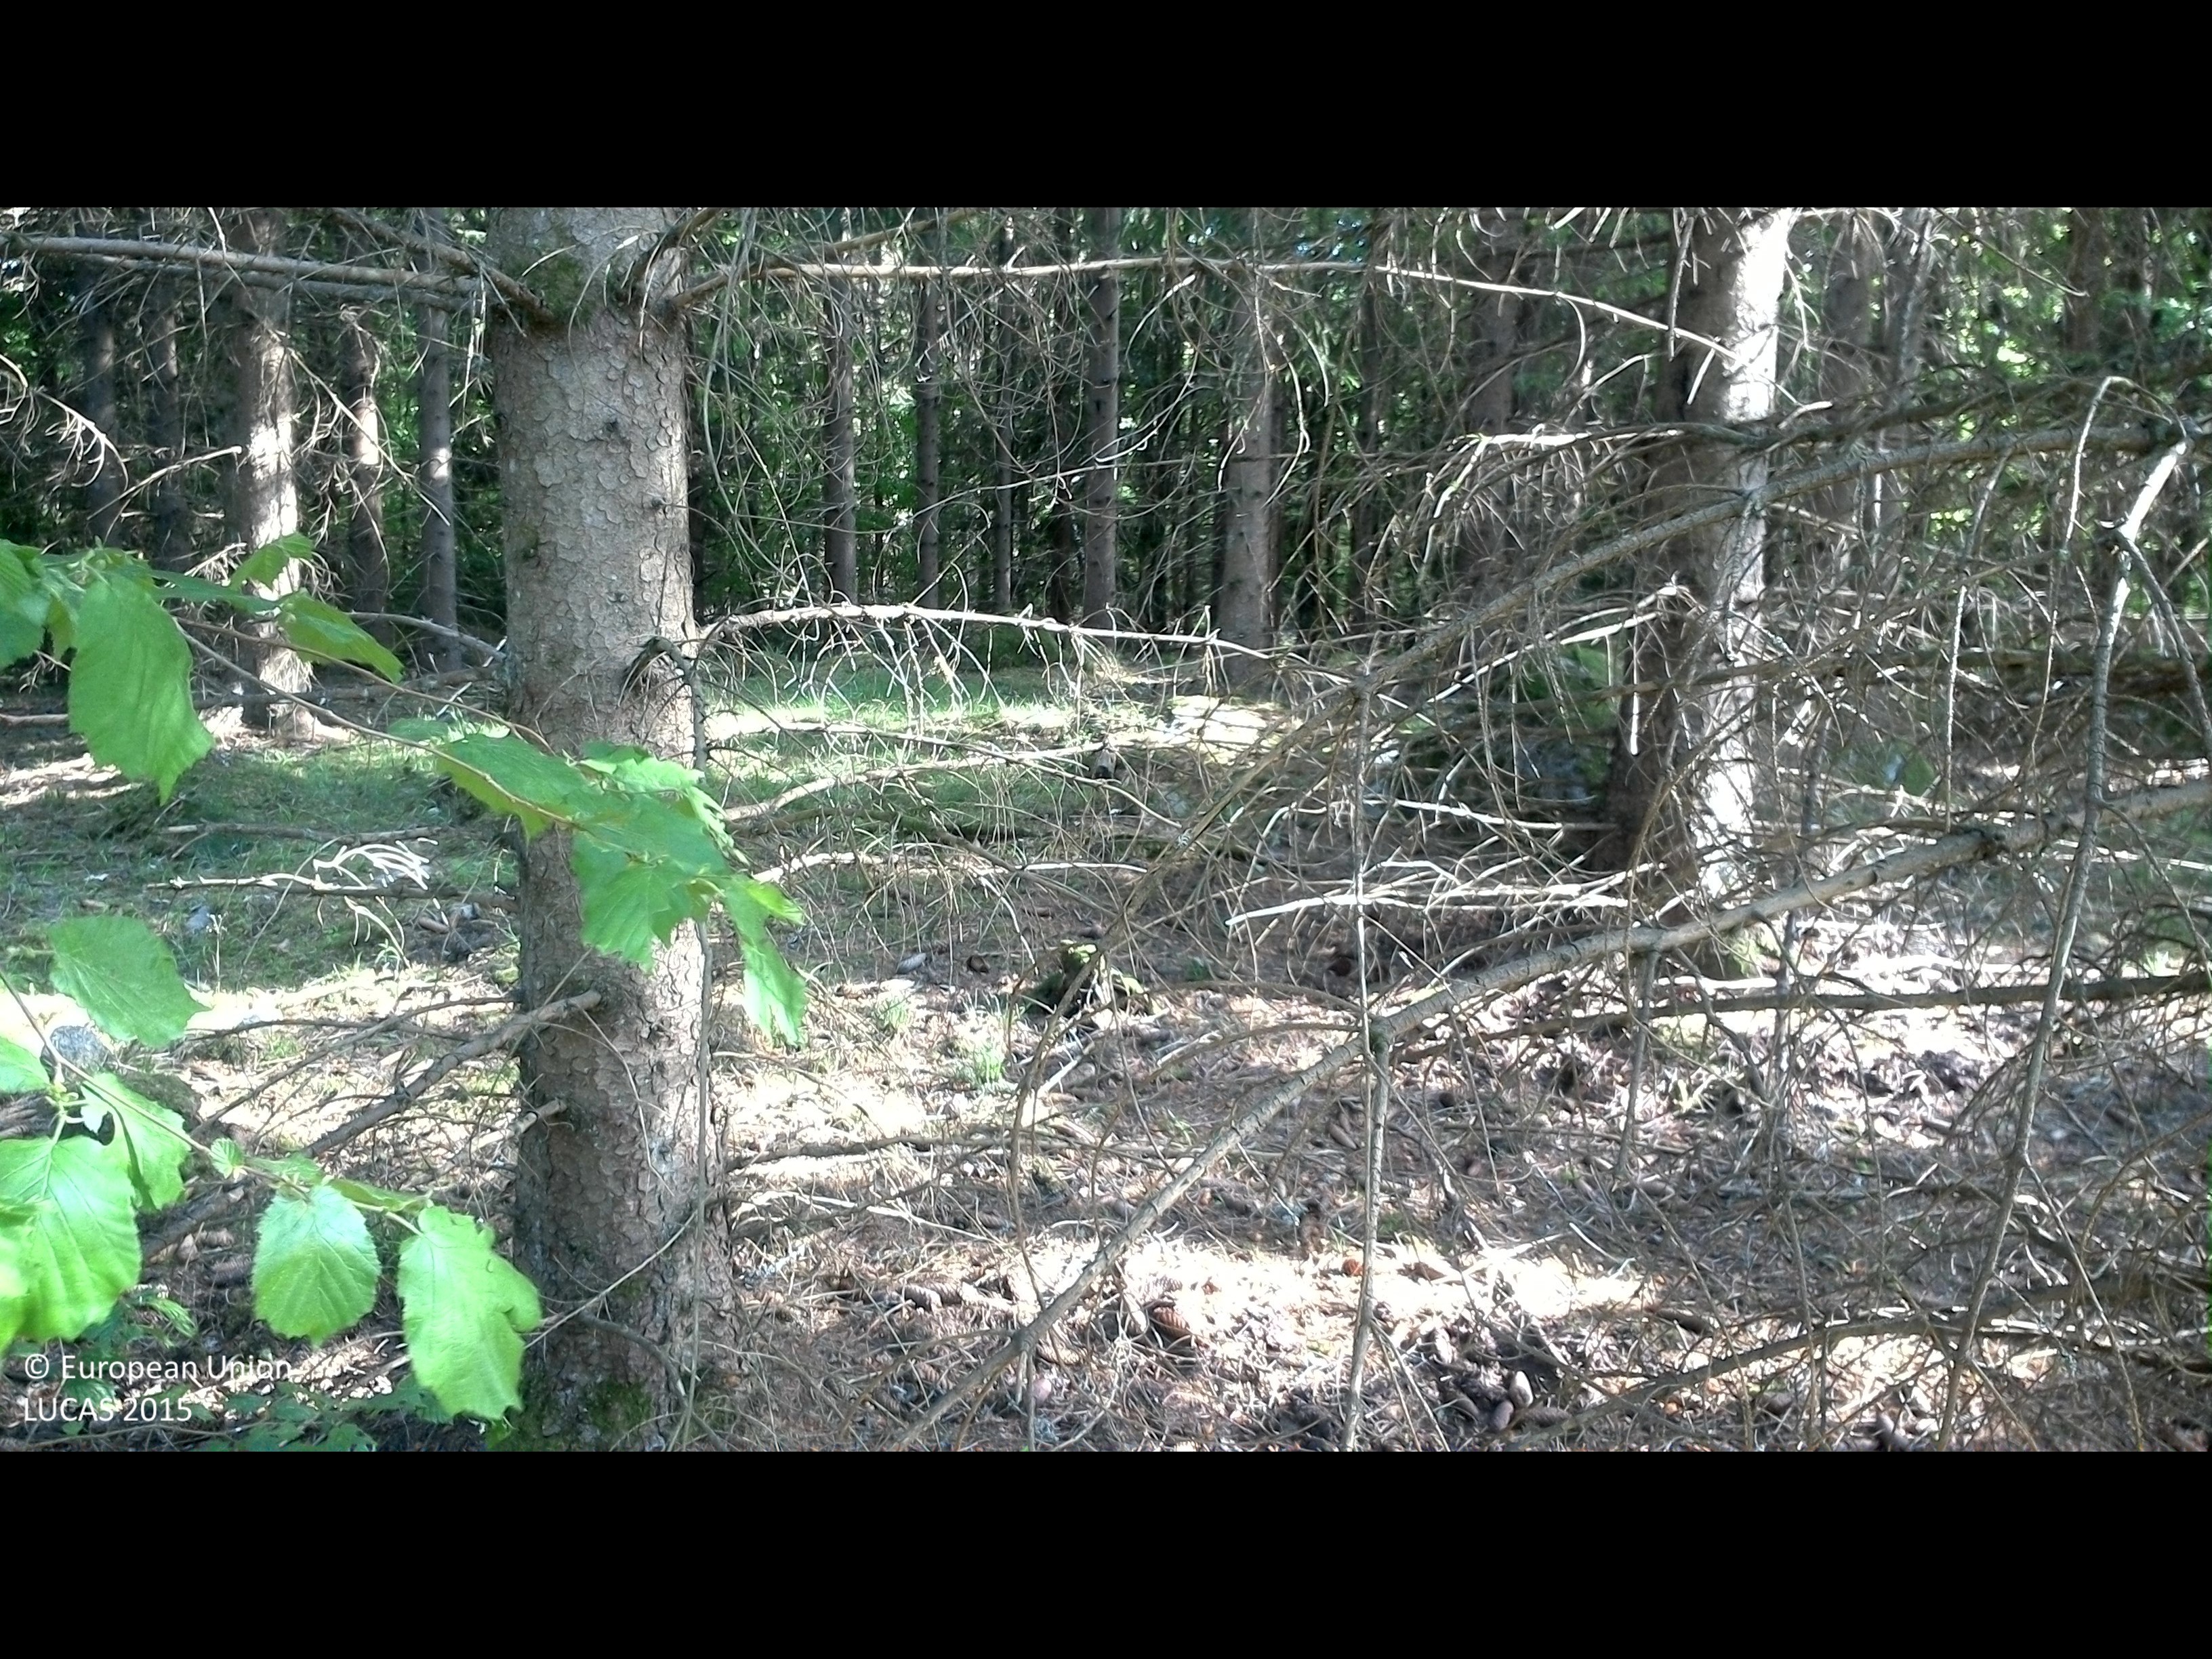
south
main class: Woodland
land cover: Spruce dominated mixed woodland
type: boreal forest
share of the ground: > 75 %
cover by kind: coniferous forest trees 60 %, broadleaved forest trees 20 %, herbaceous plants 20 %
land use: Forestry
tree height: > 5 m
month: June
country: SE
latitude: 56.5955
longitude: 15.8464
